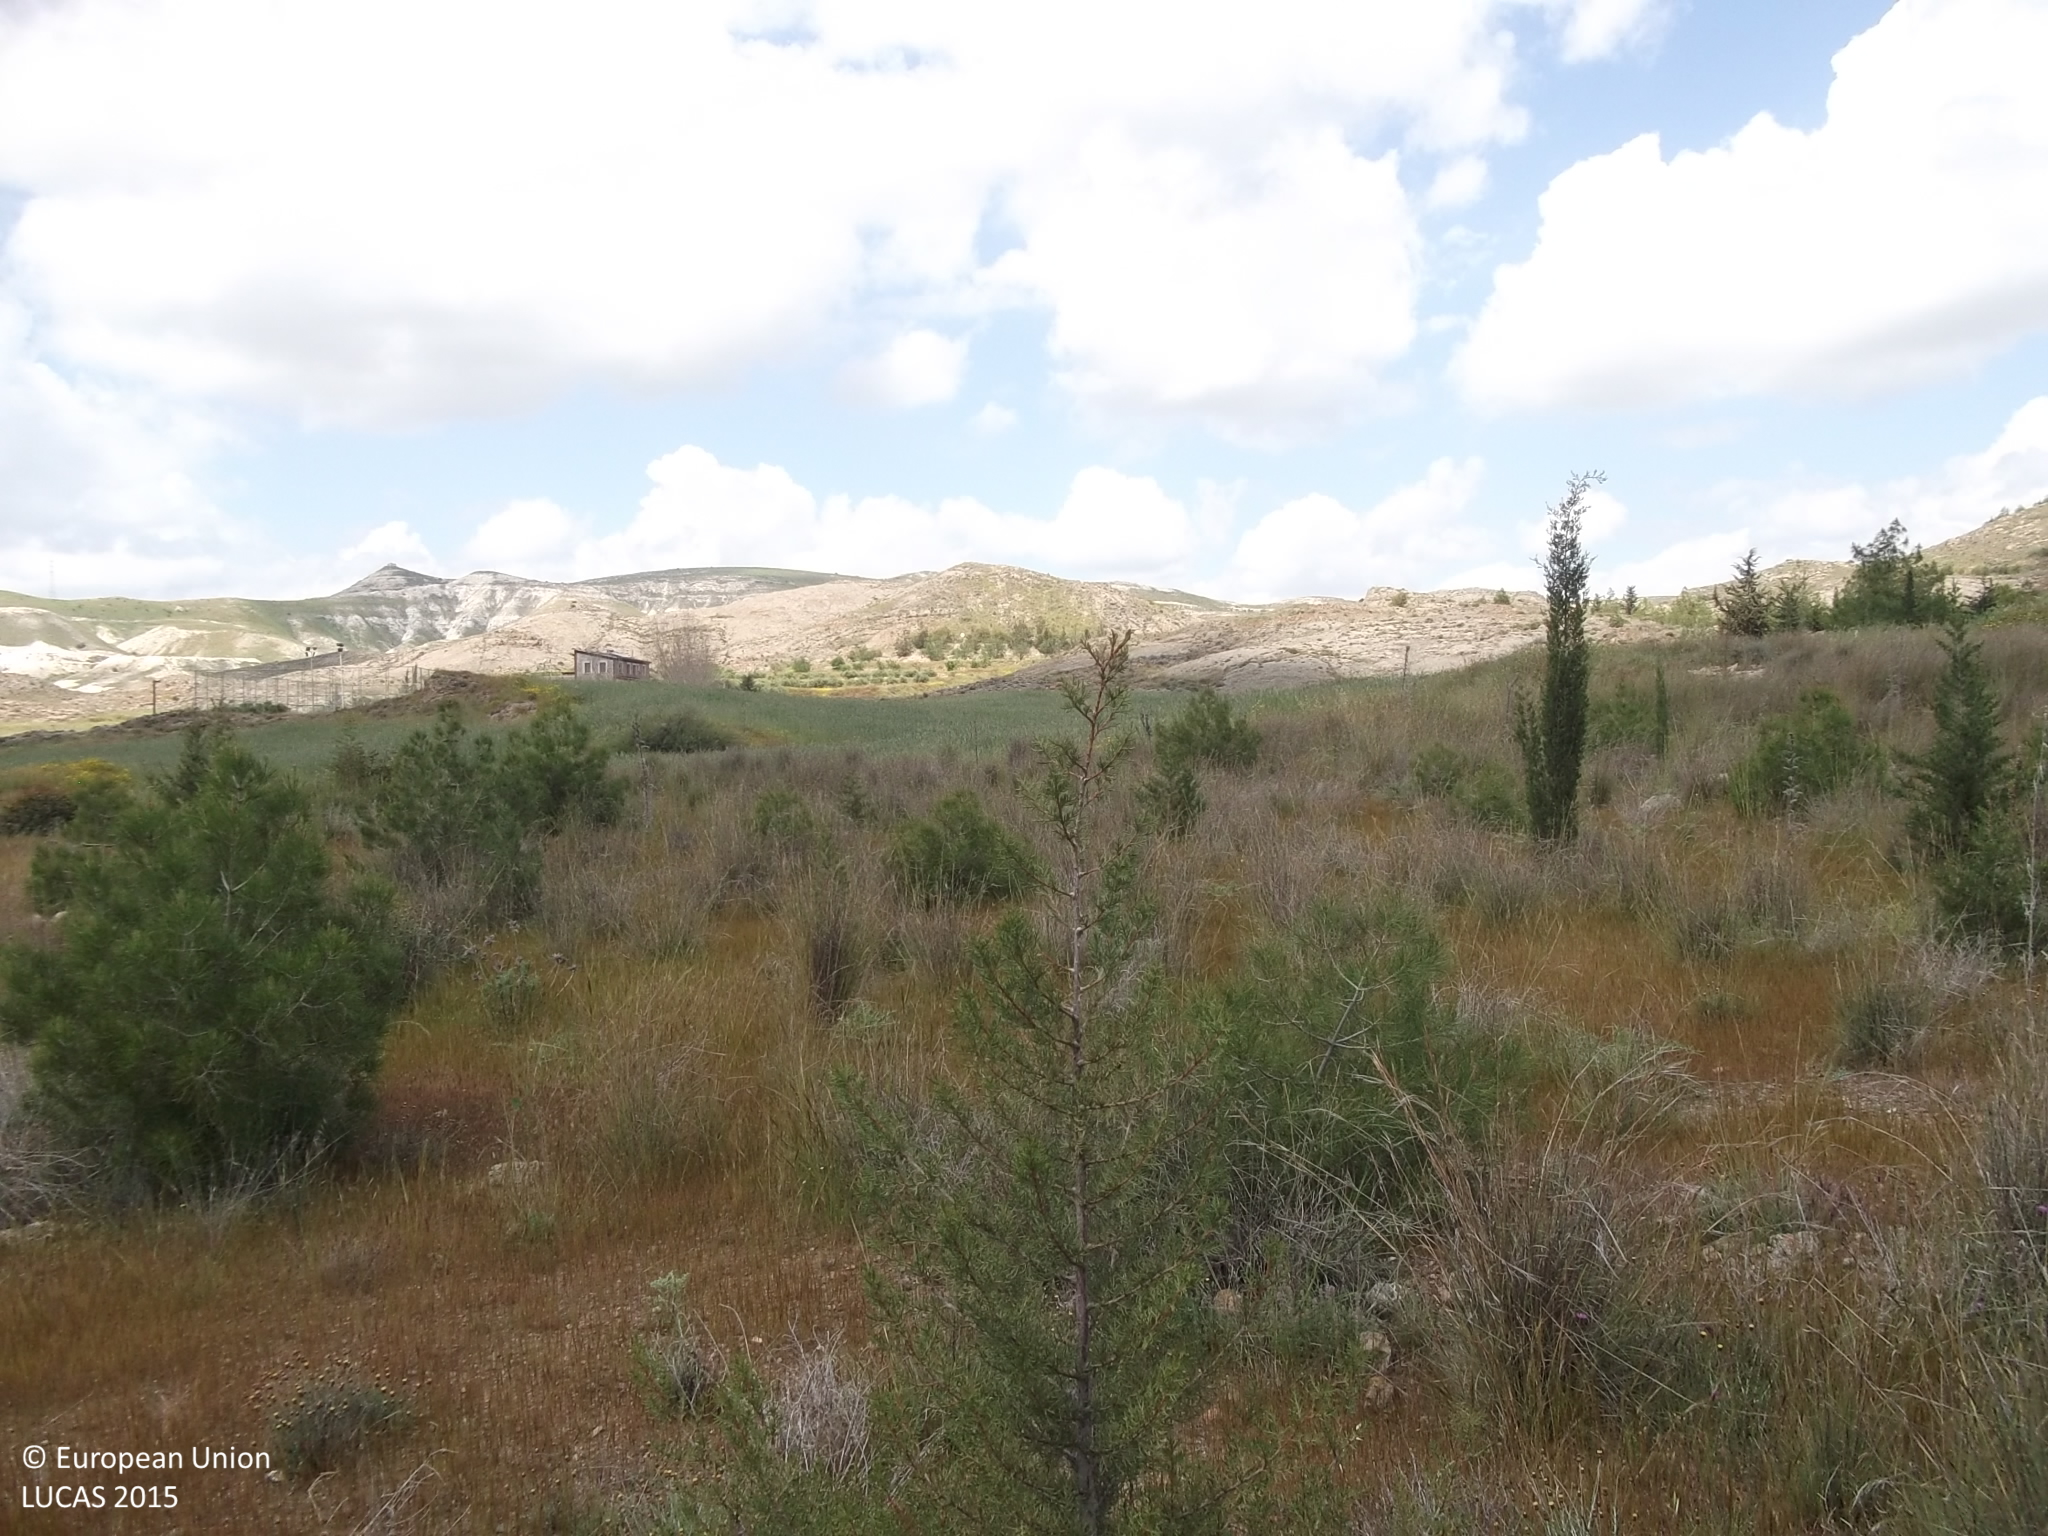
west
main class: Shrubland
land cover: Shrubland with sparse tree cover
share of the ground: 50 - 75 %
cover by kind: shrubs 55 %, herbaceous plants 30 %, consolidated bare surface 10 %, coniferous forest trees 5 %
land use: Semi-natural and natural areas not in use
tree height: < 5 m
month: April
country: CY
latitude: 35.0034
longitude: 33.5686
